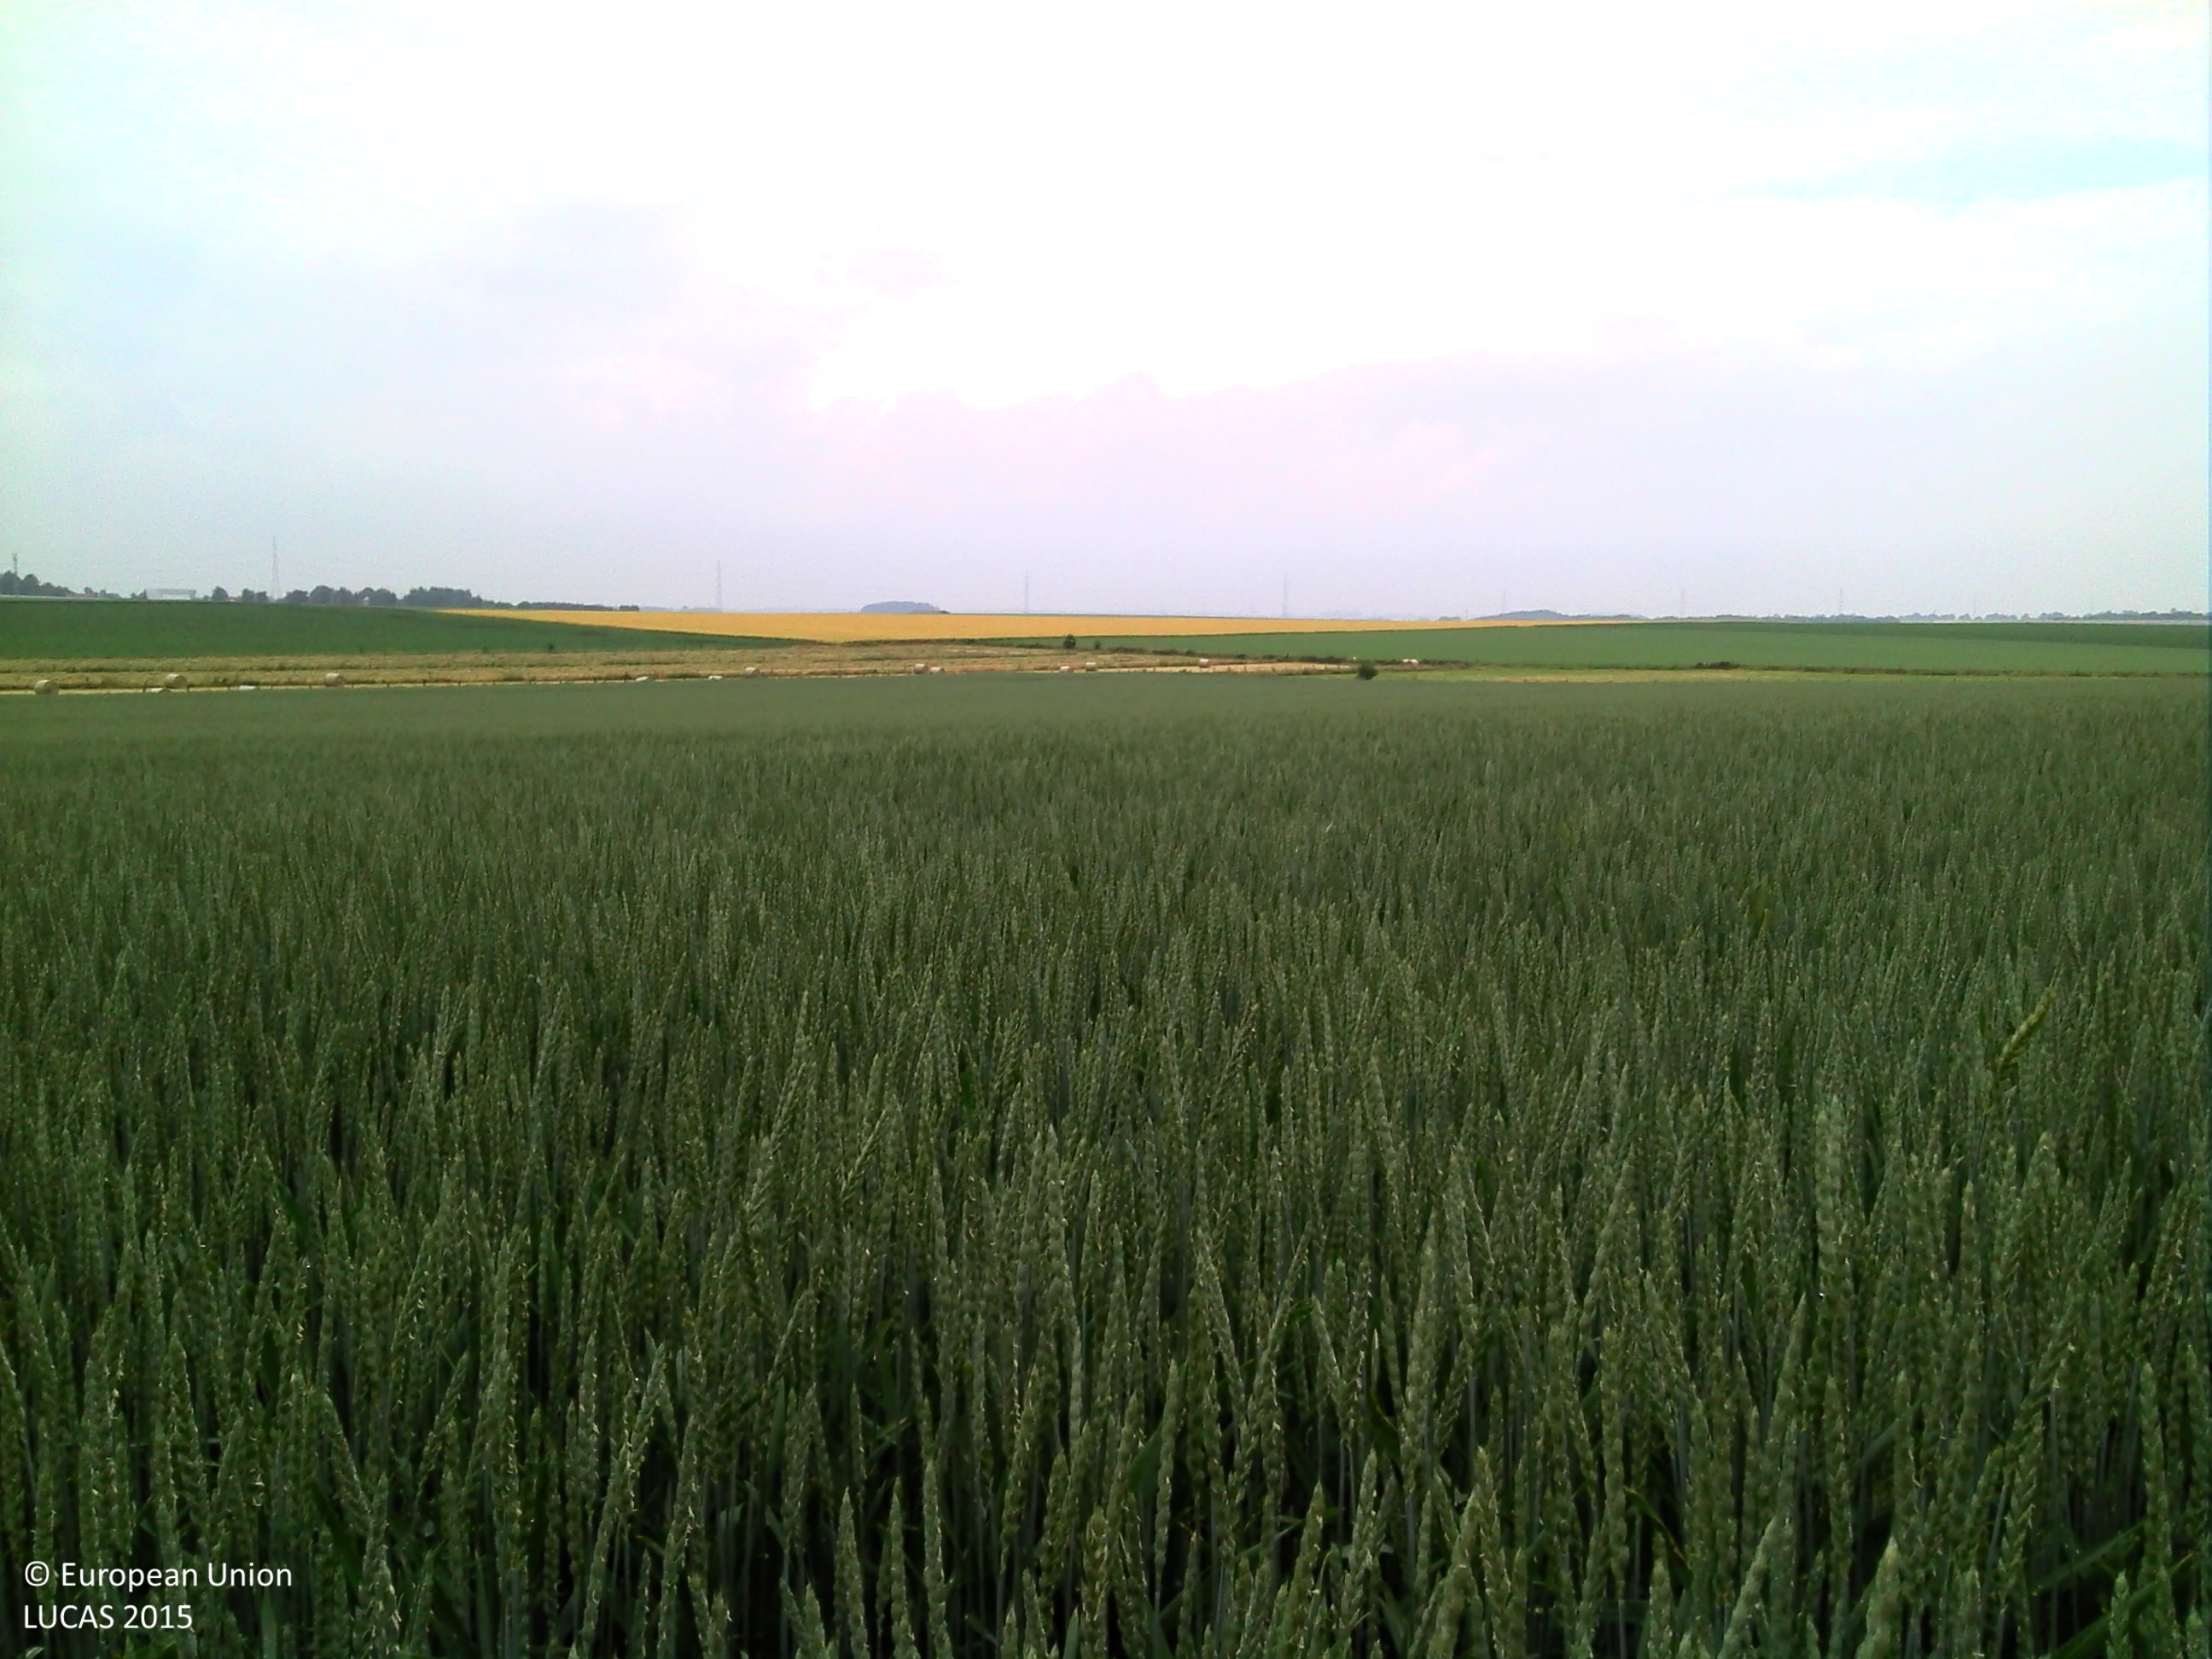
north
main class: Cropland
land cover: Other cereals
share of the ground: > 75 %
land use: Agriculture (excluding fallow land and kitchen gardens)
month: June
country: BE
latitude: 50.7070
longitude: 5.4809
